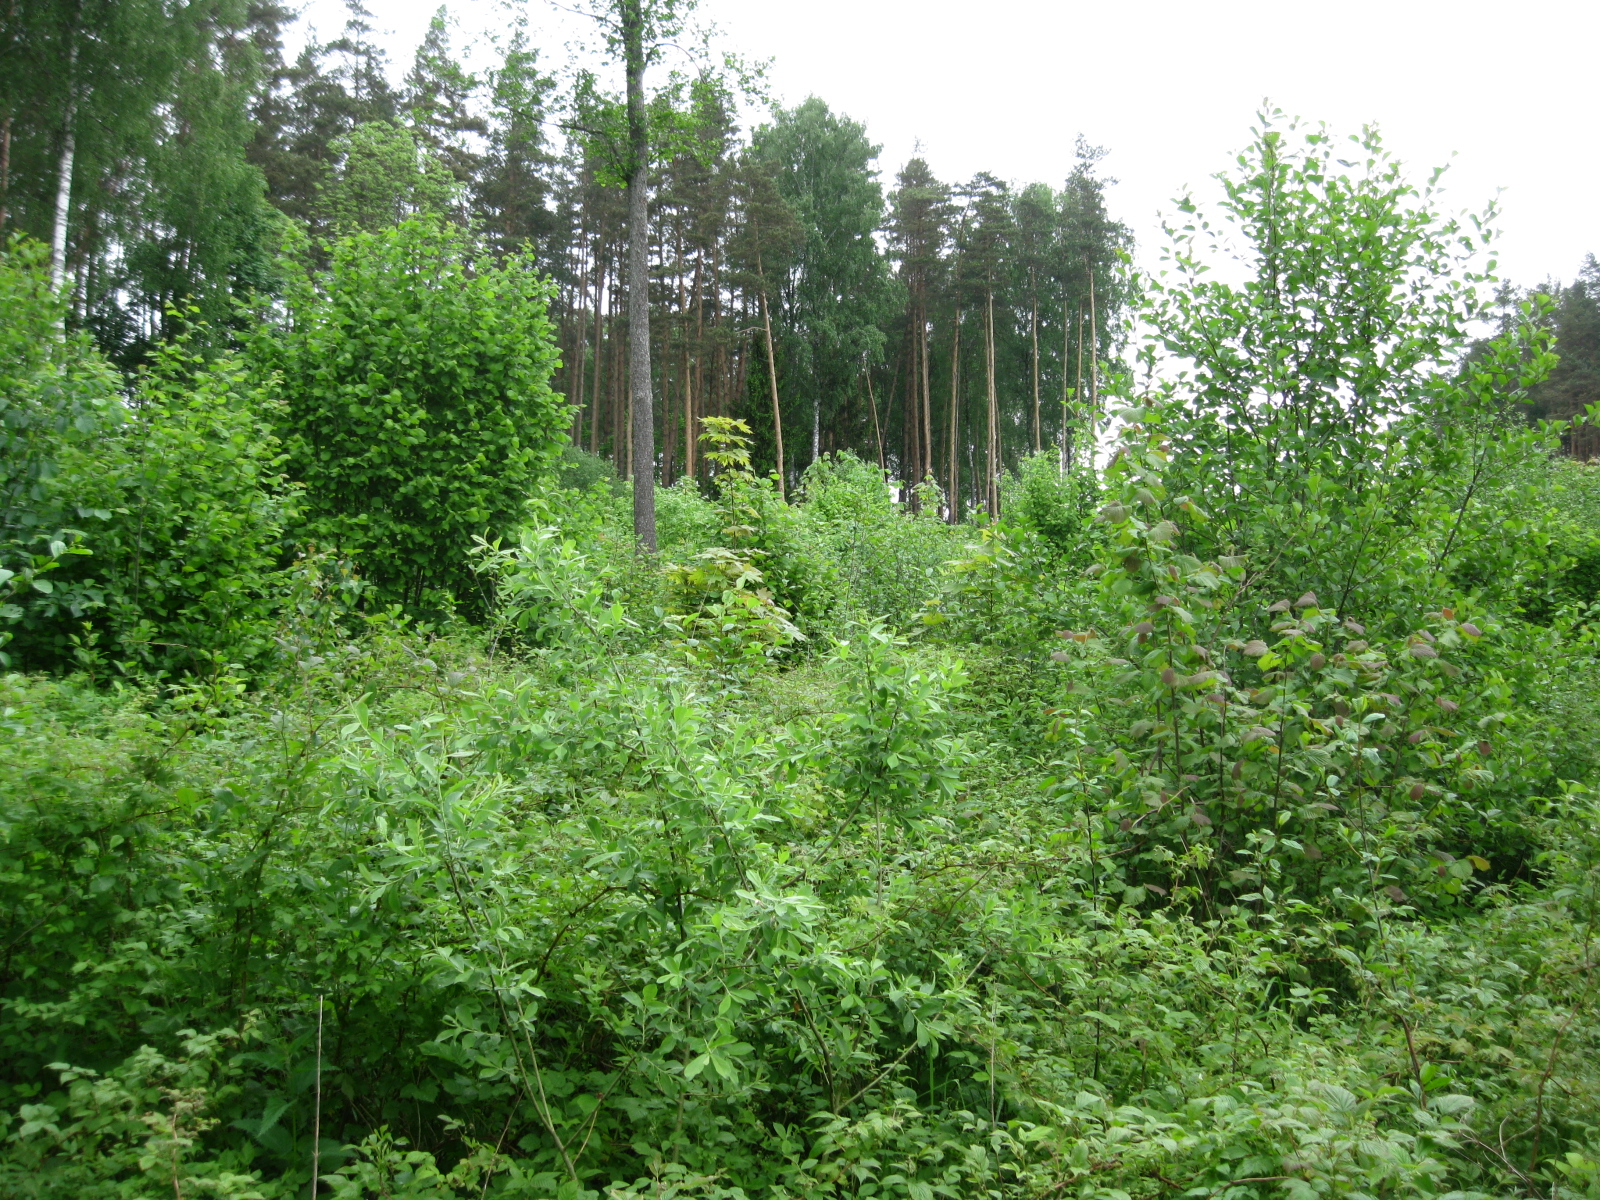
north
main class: Woodland
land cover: Broadleaved woodland
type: non-riverine alder, birch or aspen forest
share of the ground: > 75 %
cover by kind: broadleaved forest trees 80 %, shrubs 15 %, herbaceous plants 5 %
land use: Forestry
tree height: < 5 m
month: June
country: LT
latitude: 55.8817
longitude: 24.0770
